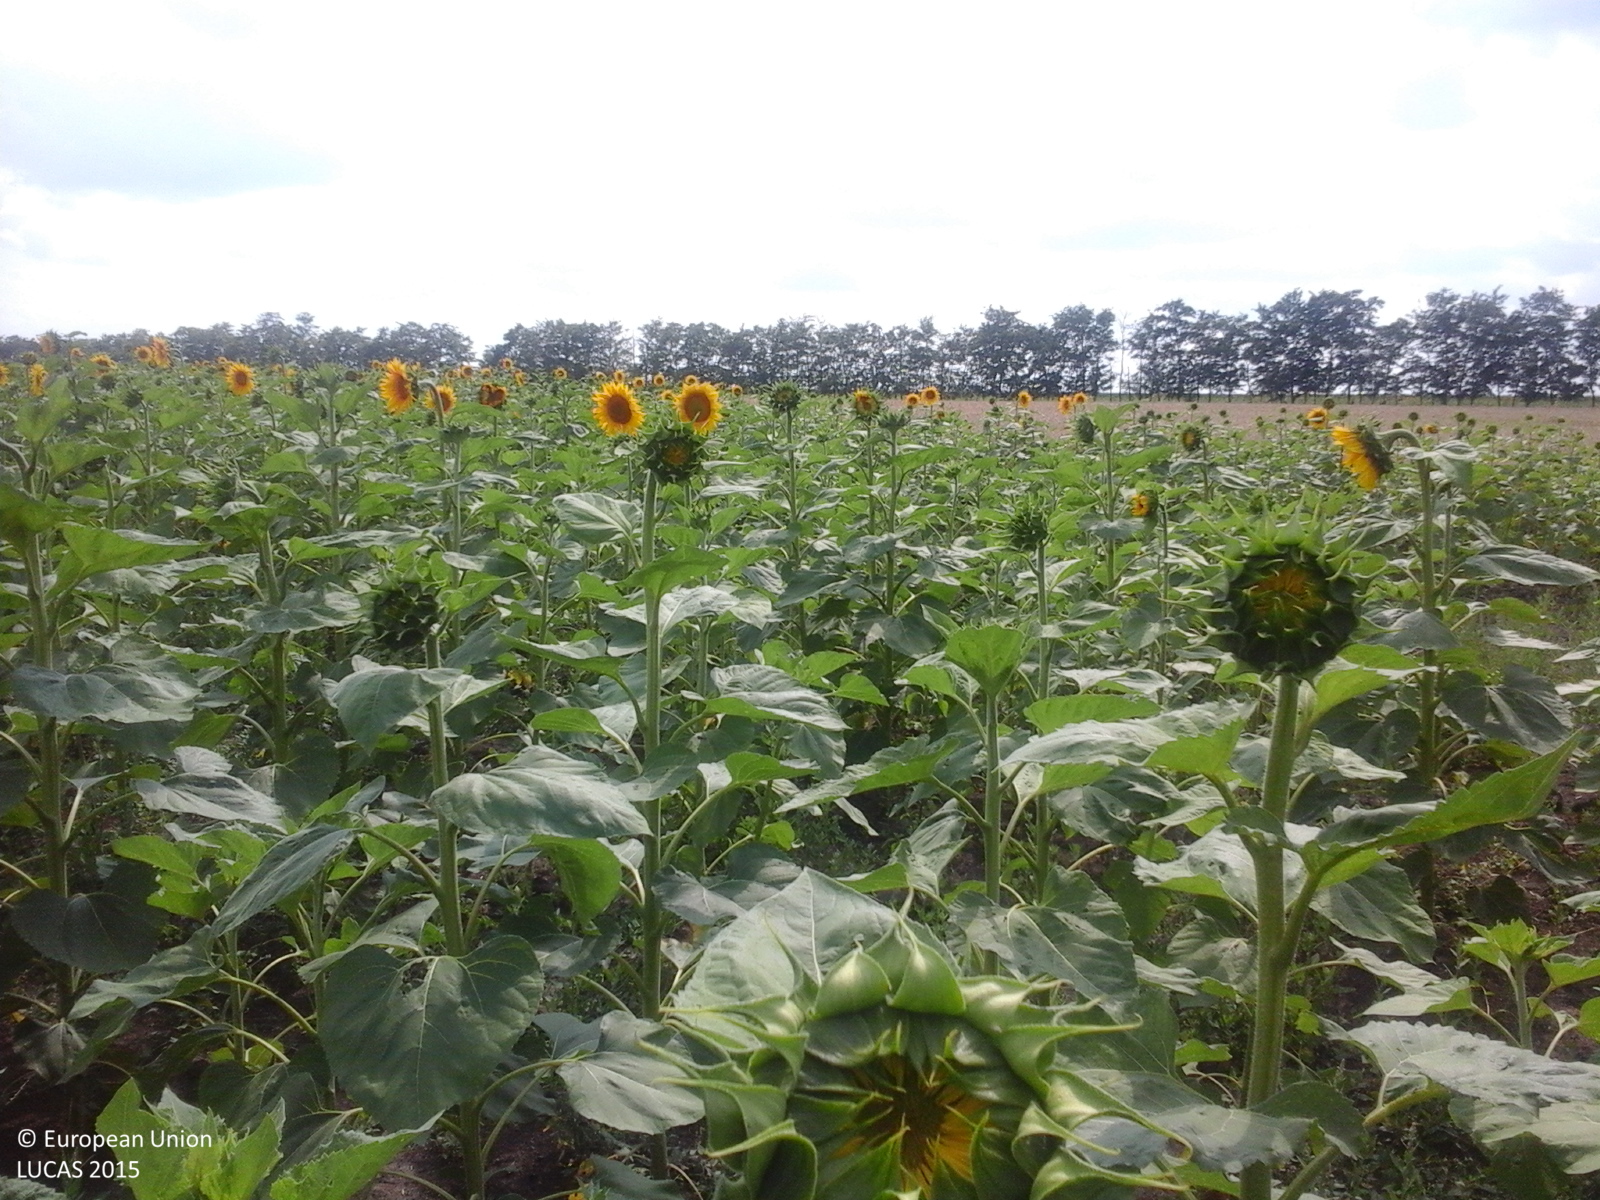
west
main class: Cropland
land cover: Sunflower
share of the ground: > 75 %
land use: Agriculture (excluding fallow land and kitchen gardens)
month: July
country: RO
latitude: 43.9815
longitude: 24.2618
